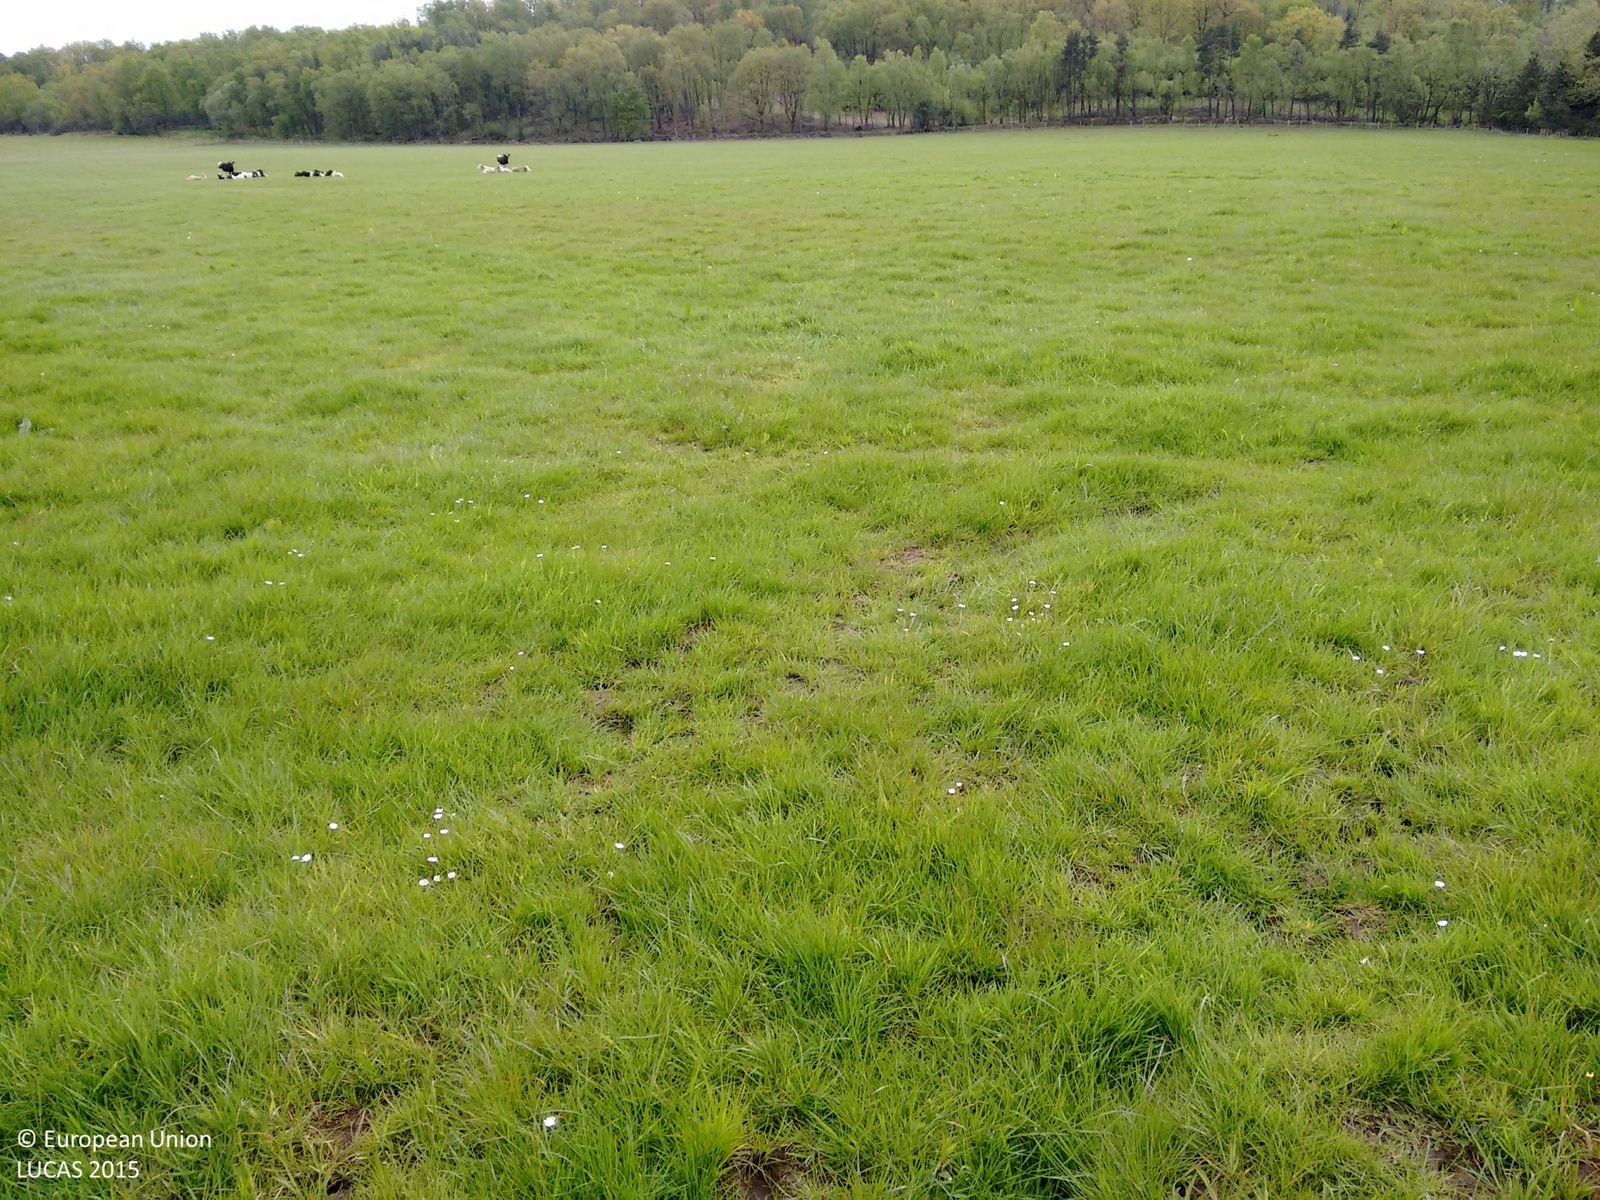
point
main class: Grassland
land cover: Grassland without tree/shrub cover
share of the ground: > 75 %
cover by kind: herbaceous plants 100 %
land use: Agriculture (excluding fallow land and kitchen gardens)
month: May
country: GB
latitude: 56.1377
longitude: -3.7436
